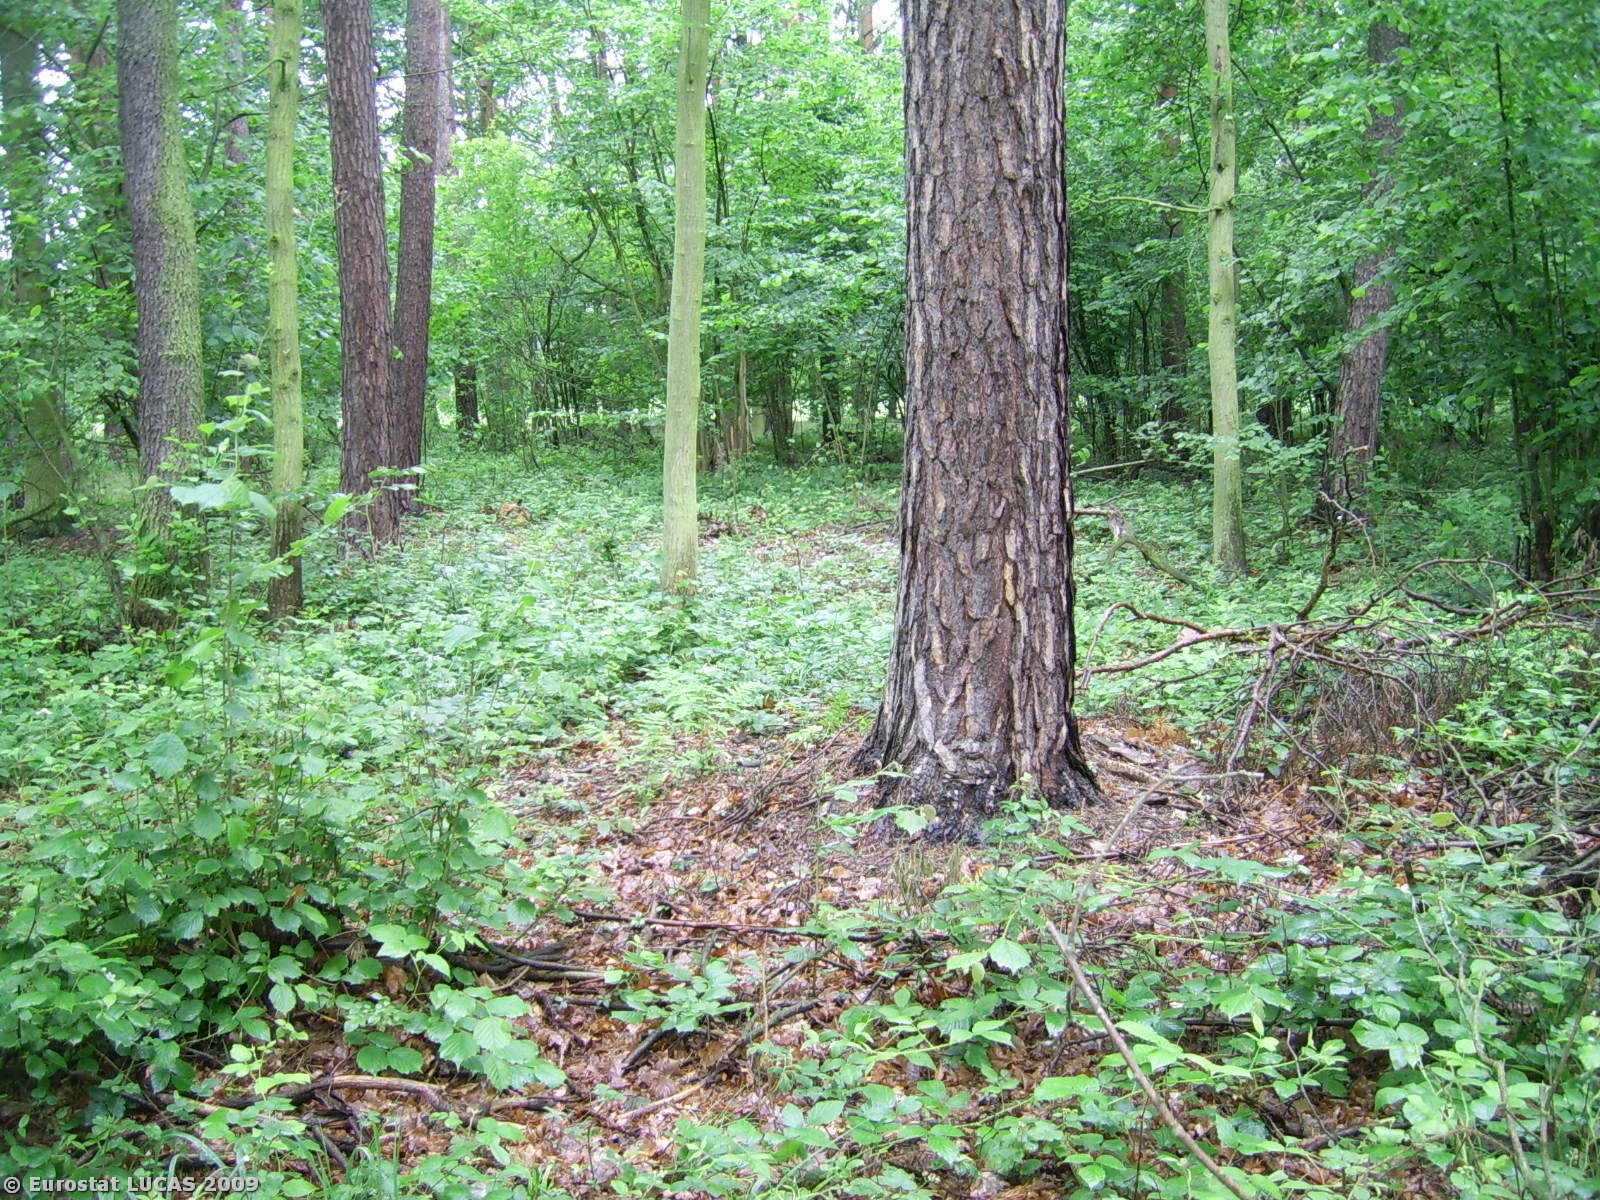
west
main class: Woodland
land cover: Mixed woodland
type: hemiboreal forest and nemoral coniferous forest and mixed broadleaved-coniferous forest
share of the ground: > 75 %
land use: Unused
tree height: > 5 m
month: June
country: PL
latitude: 51.5816
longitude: 18.0254
